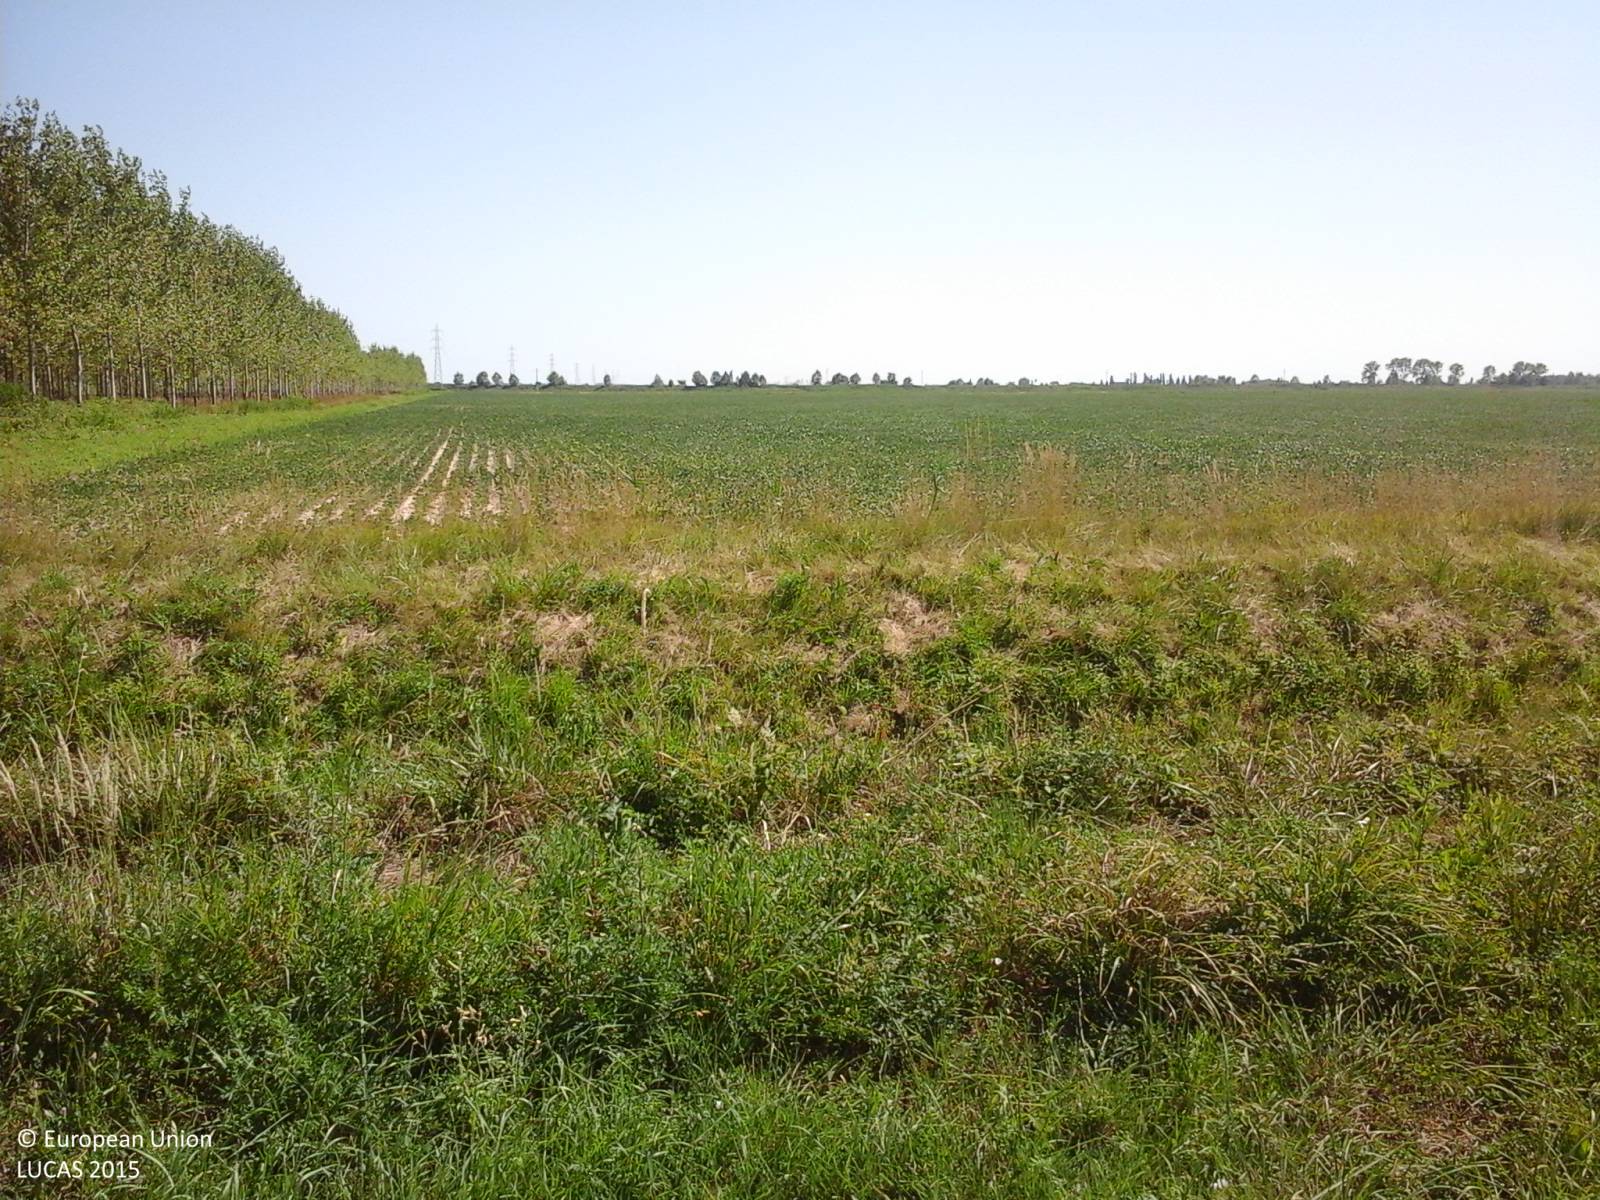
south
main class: Cropland
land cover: Sugar beet
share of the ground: > 75 %
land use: Agriculture (excluding fallow land and kitchen gardens)
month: July
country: IT
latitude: 45.6958
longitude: 13.0139
